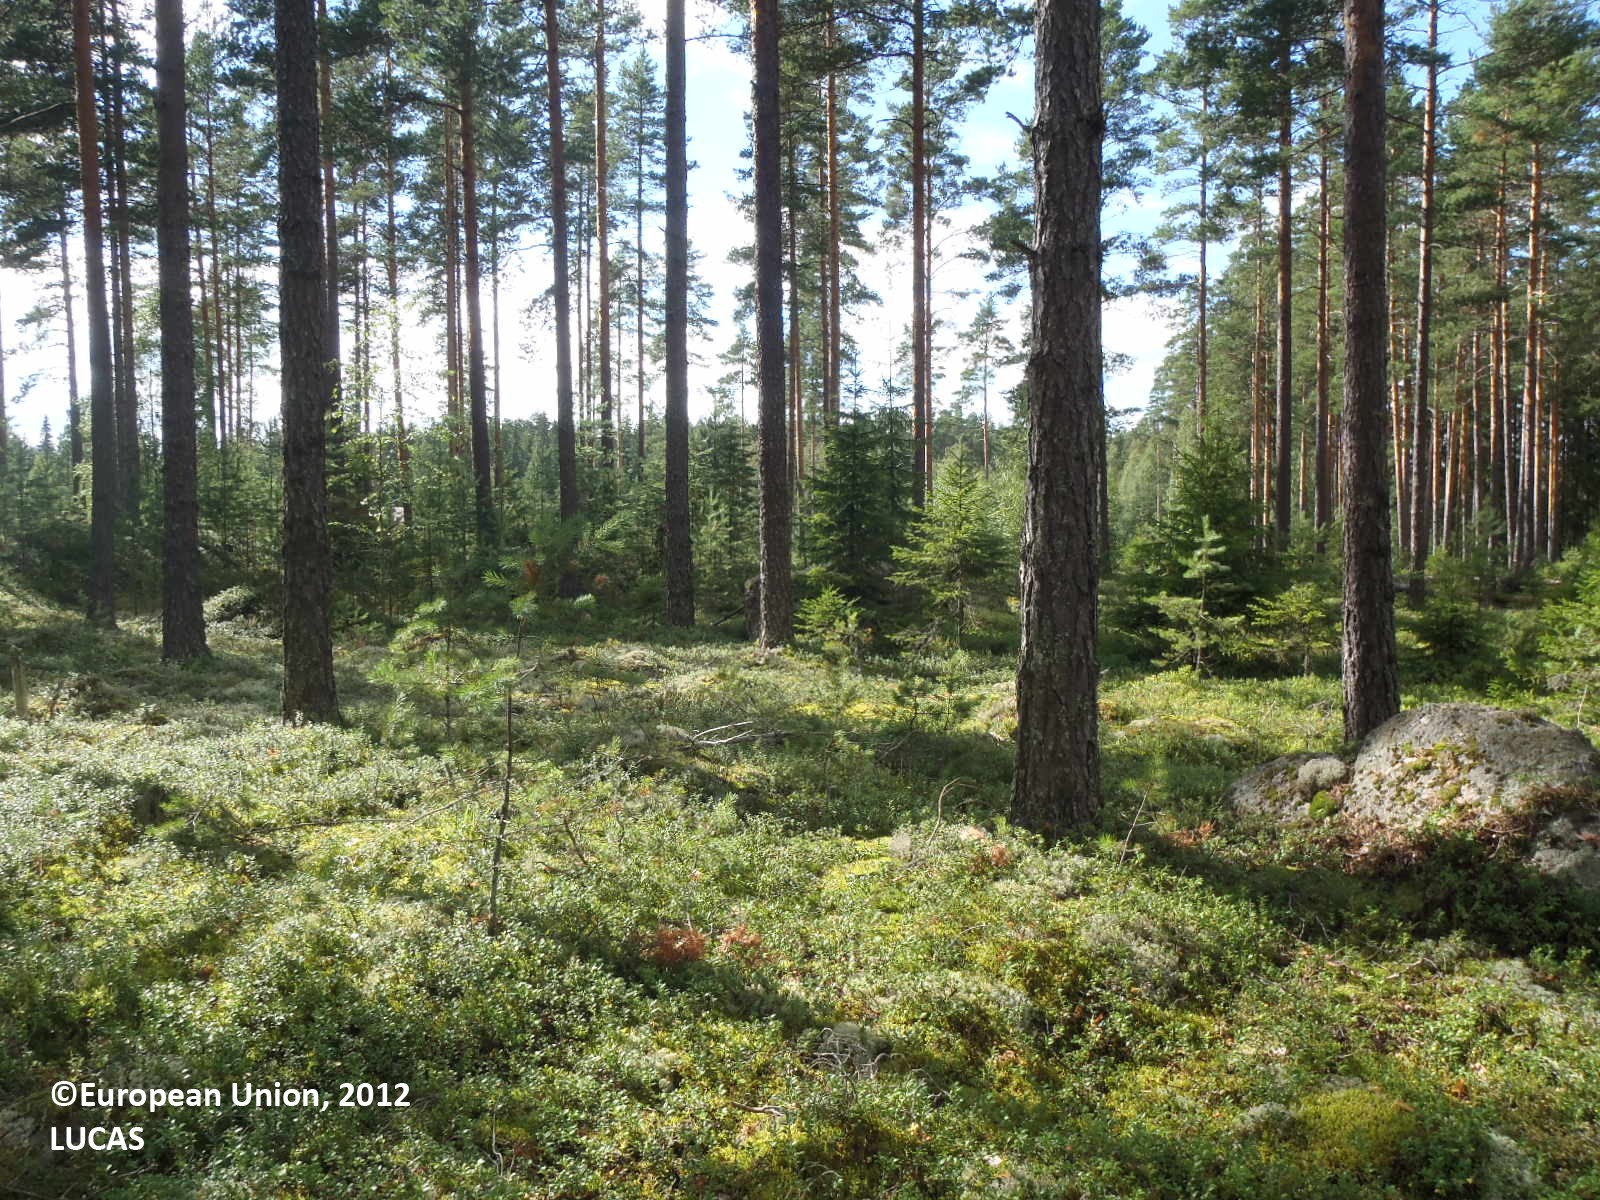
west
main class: Woodland
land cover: Pine dominated coniferous woodland
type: boreal forest
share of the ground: 50 - 75 %
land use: Forestry
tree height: > 5 m
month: July
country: FI
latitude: 60.8166
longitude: 21.7694
